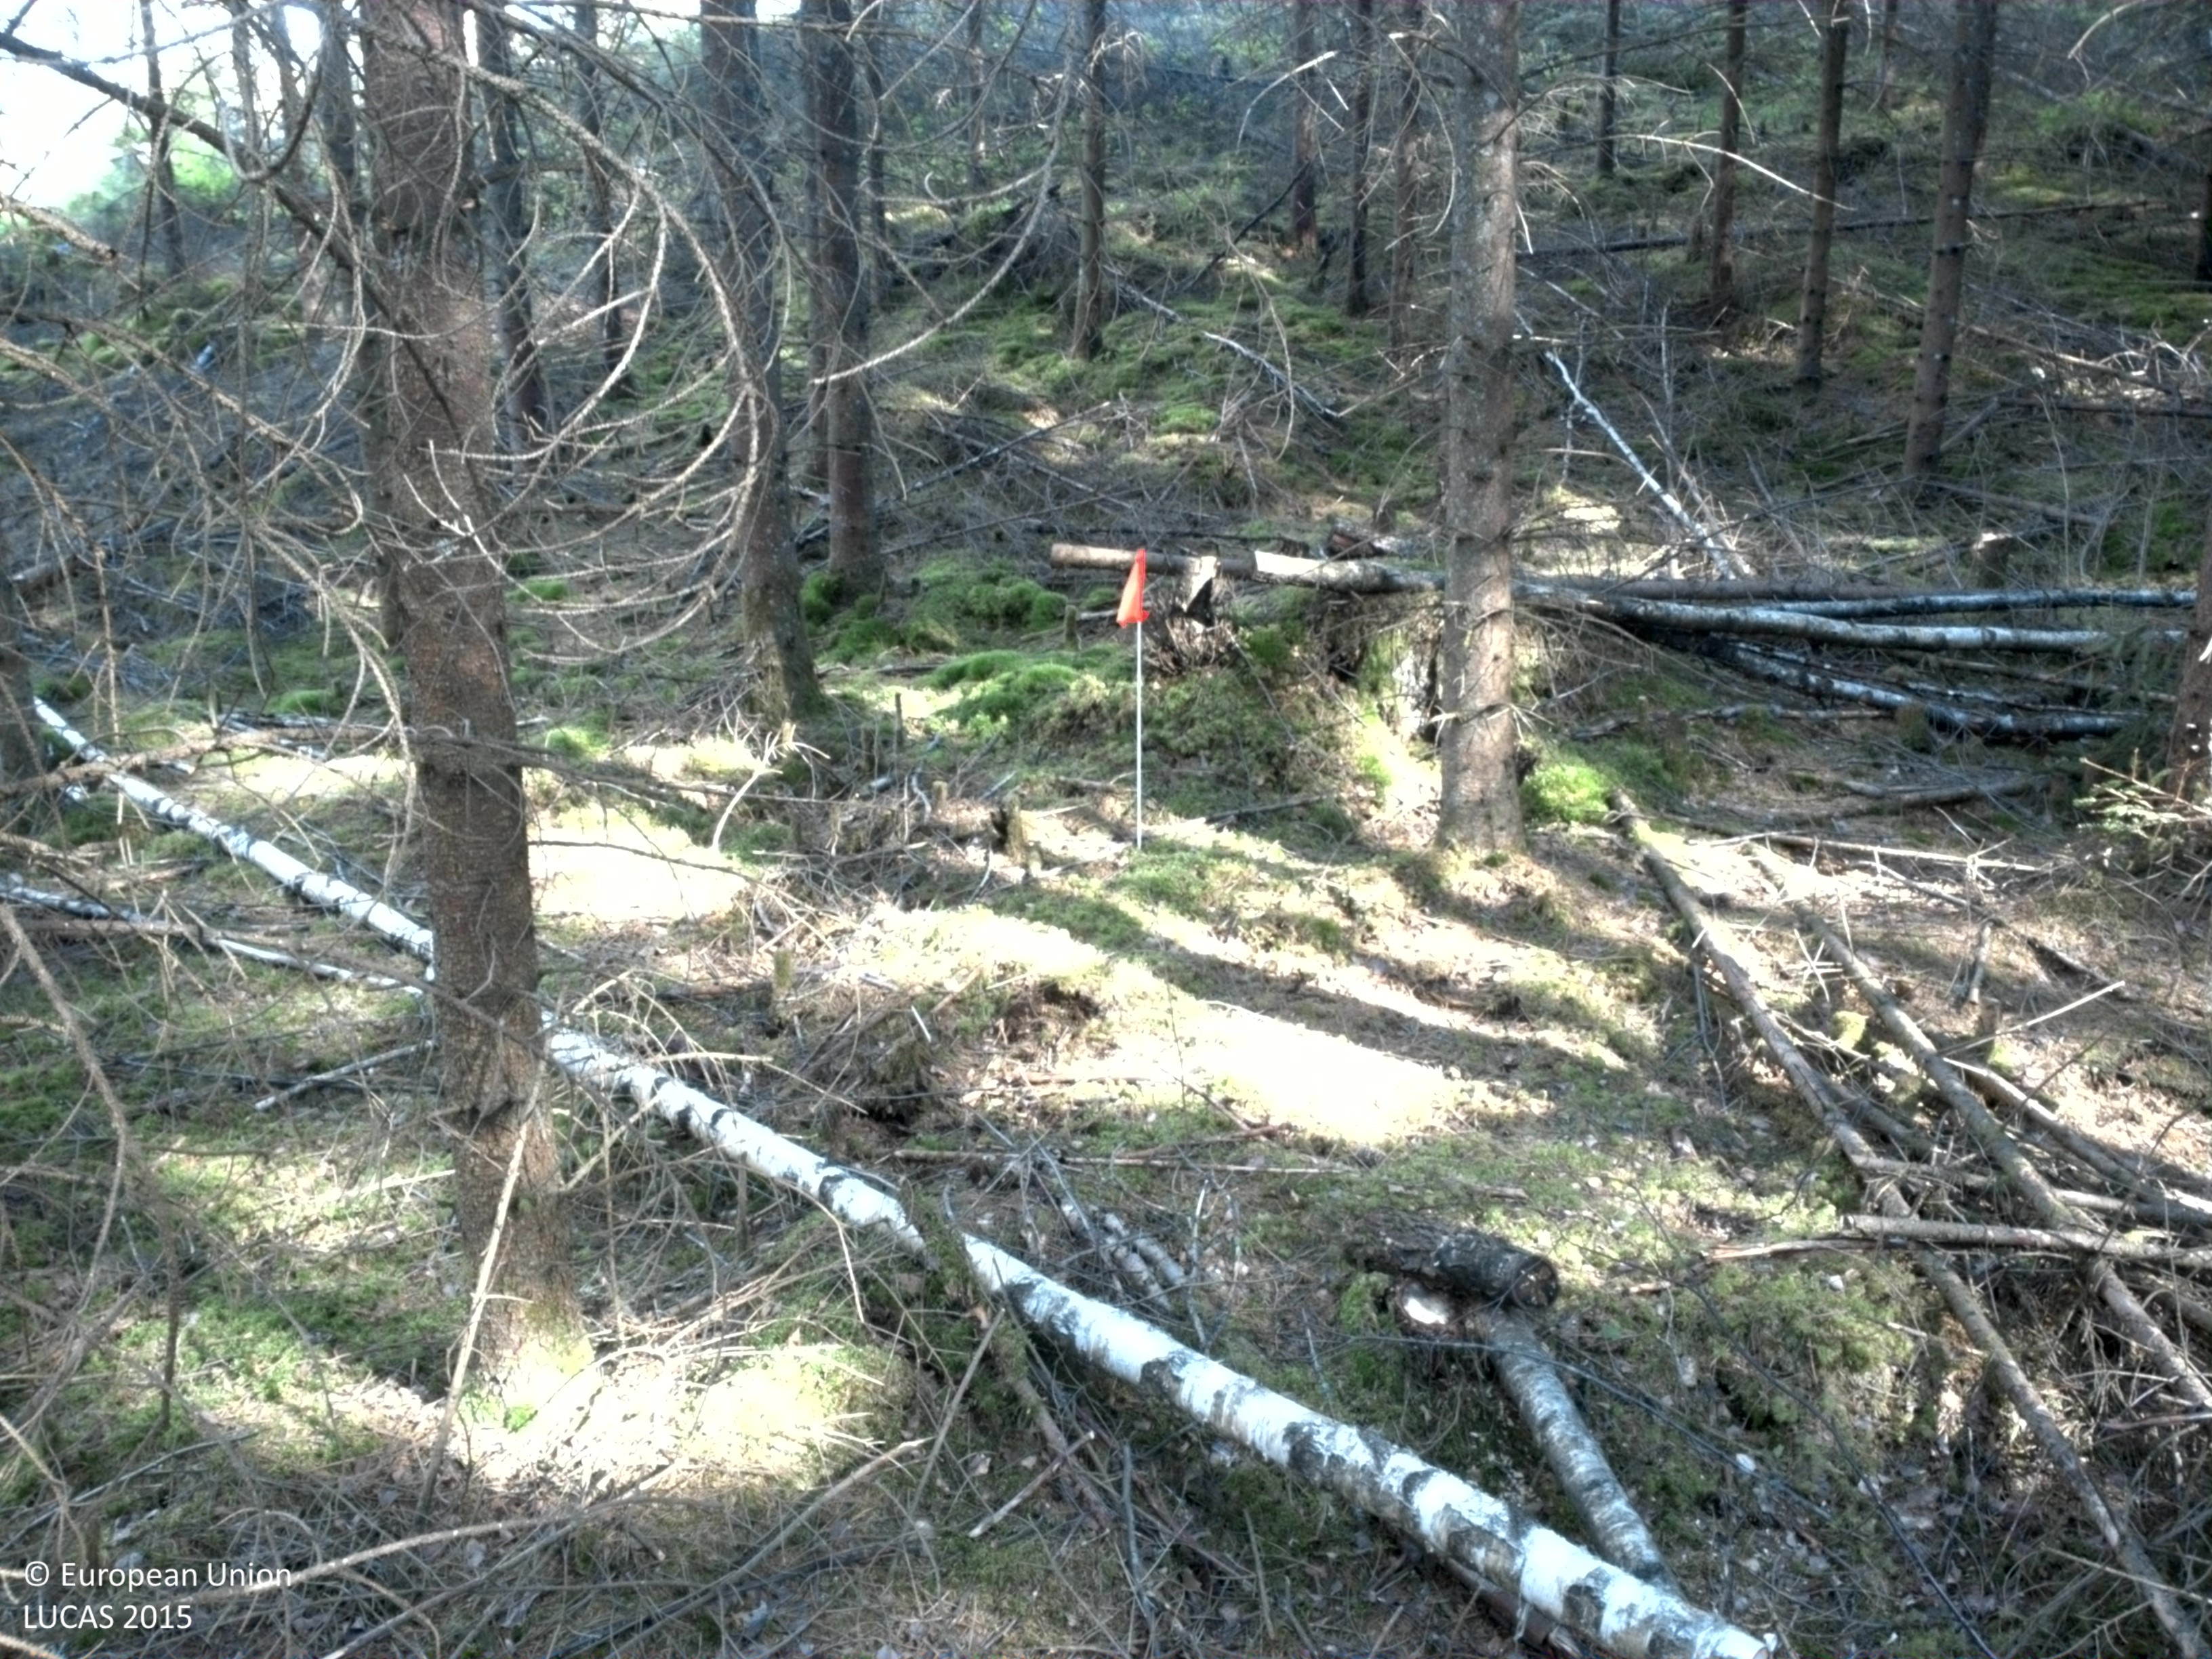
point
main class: Woodland
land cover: Spruce dominated coniferous woodland
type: boreal forest
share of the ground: > 75 %
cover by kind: coniferous forest trees 80 %, lichens and mosses 15 %, broadleaved forest trees 5 %
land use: Forestry
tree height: > 5 m
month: May
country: SE
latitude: 56.5667
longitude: 15.2549
